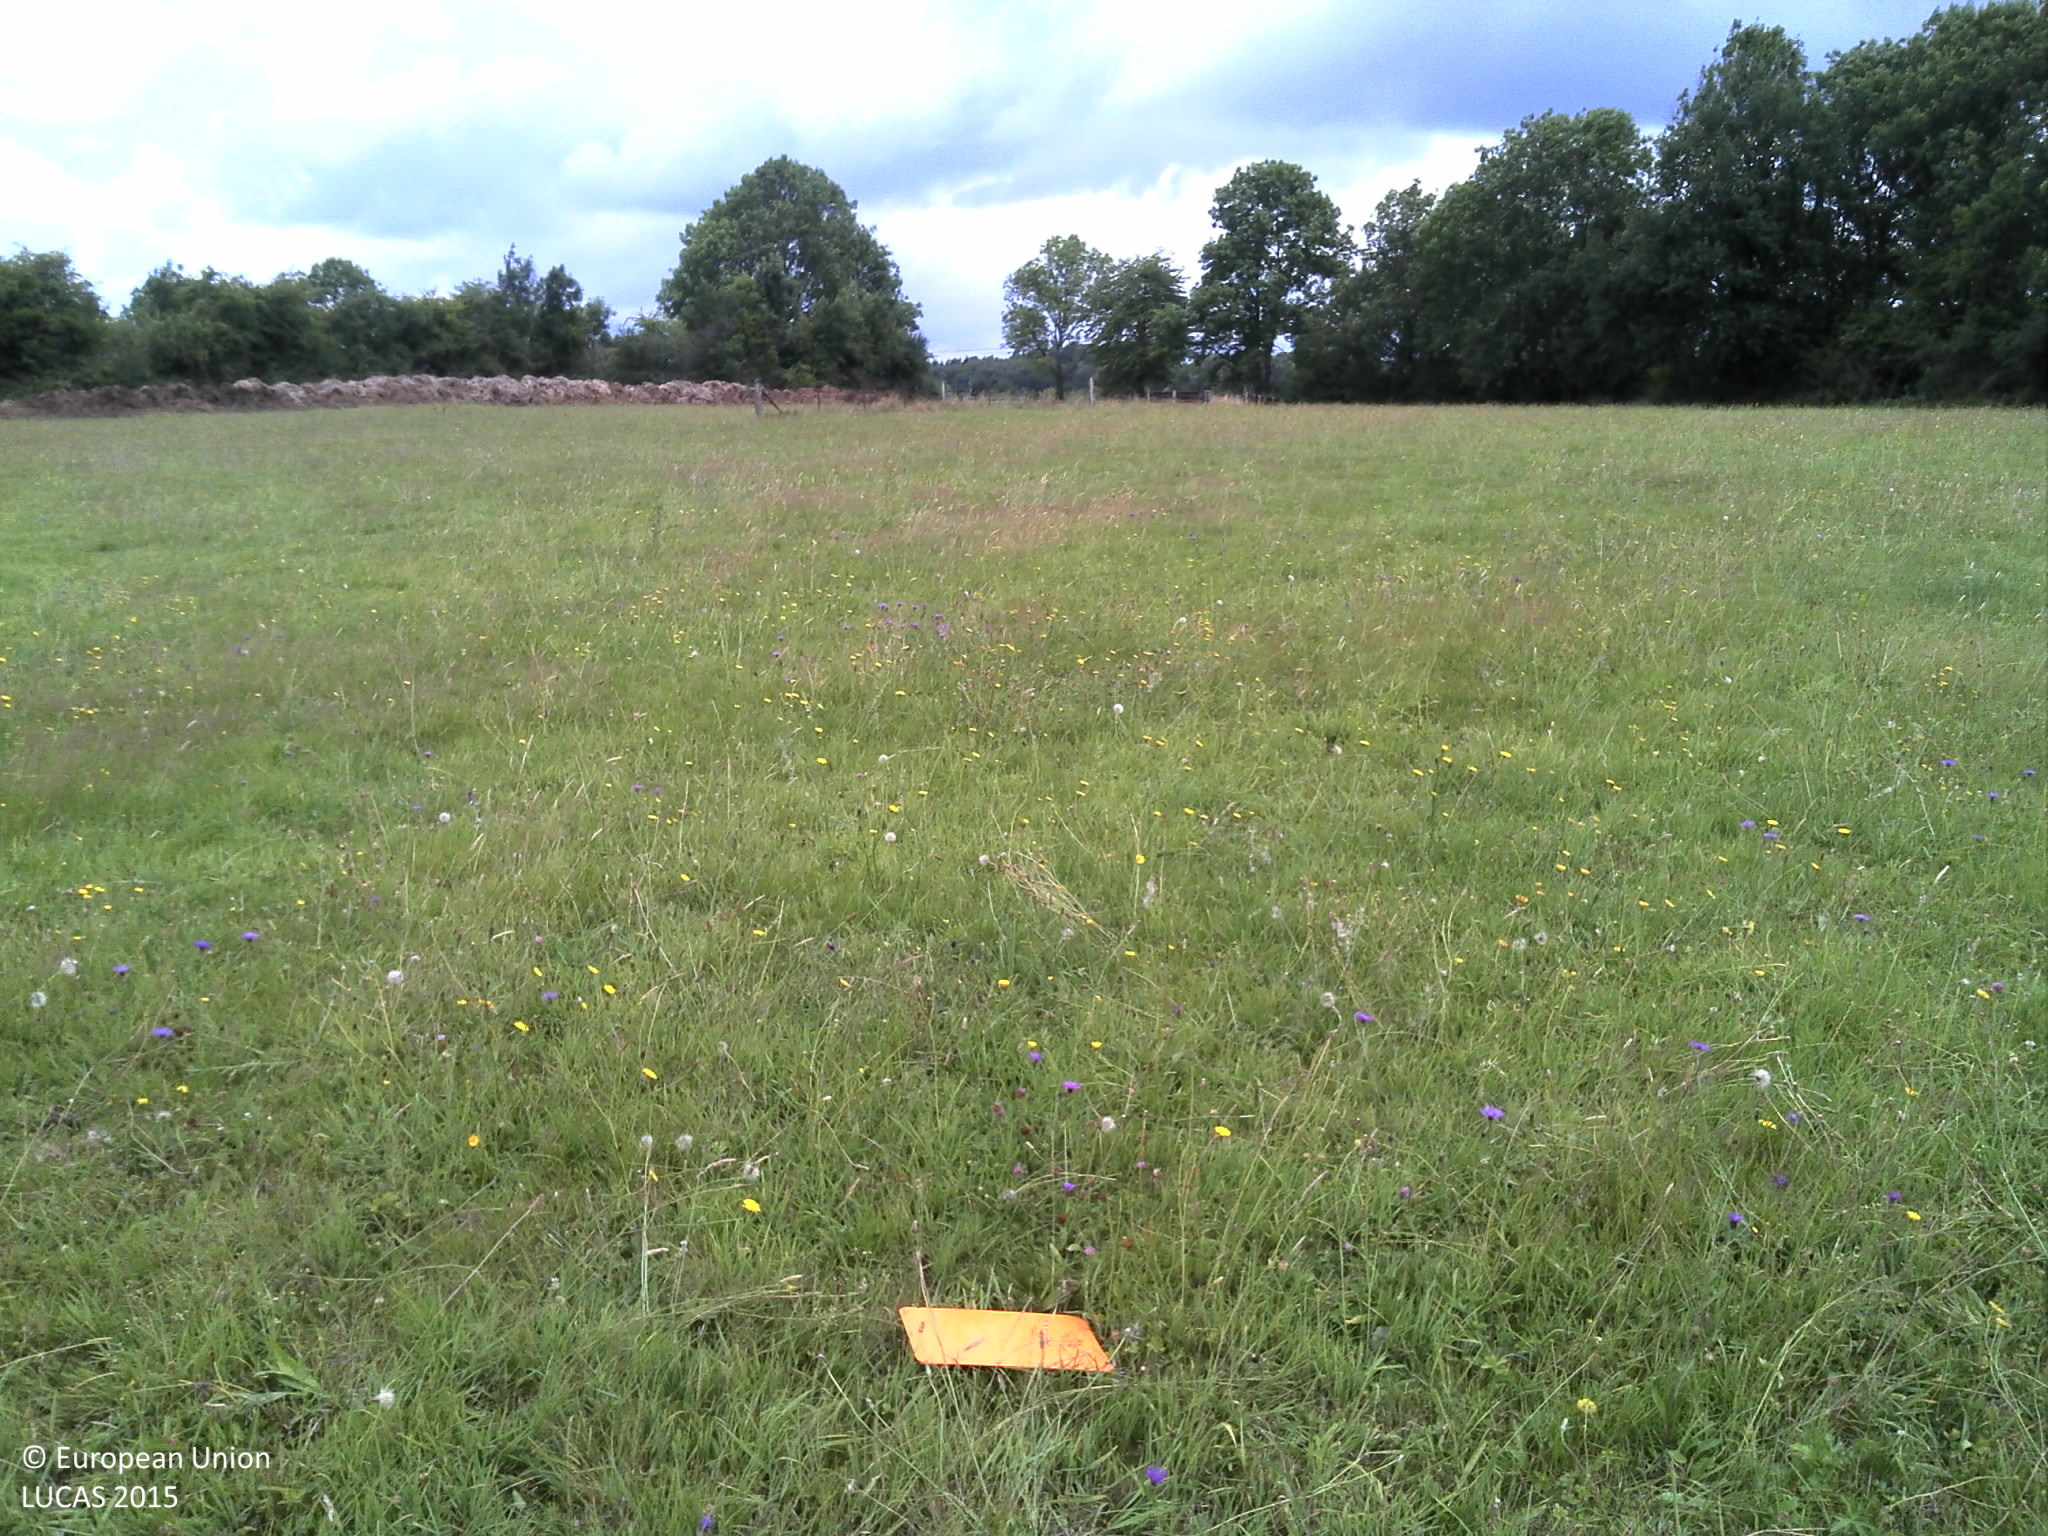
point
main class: Grassland
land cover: Grassland without tree/shrub cover
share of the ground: > 75 %
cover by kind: herbaceous plants 100 %
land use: Agriculture (excluding fallow land and kitchen gardens)
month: July
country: FR
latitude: 49.8408
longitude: 4.6151
